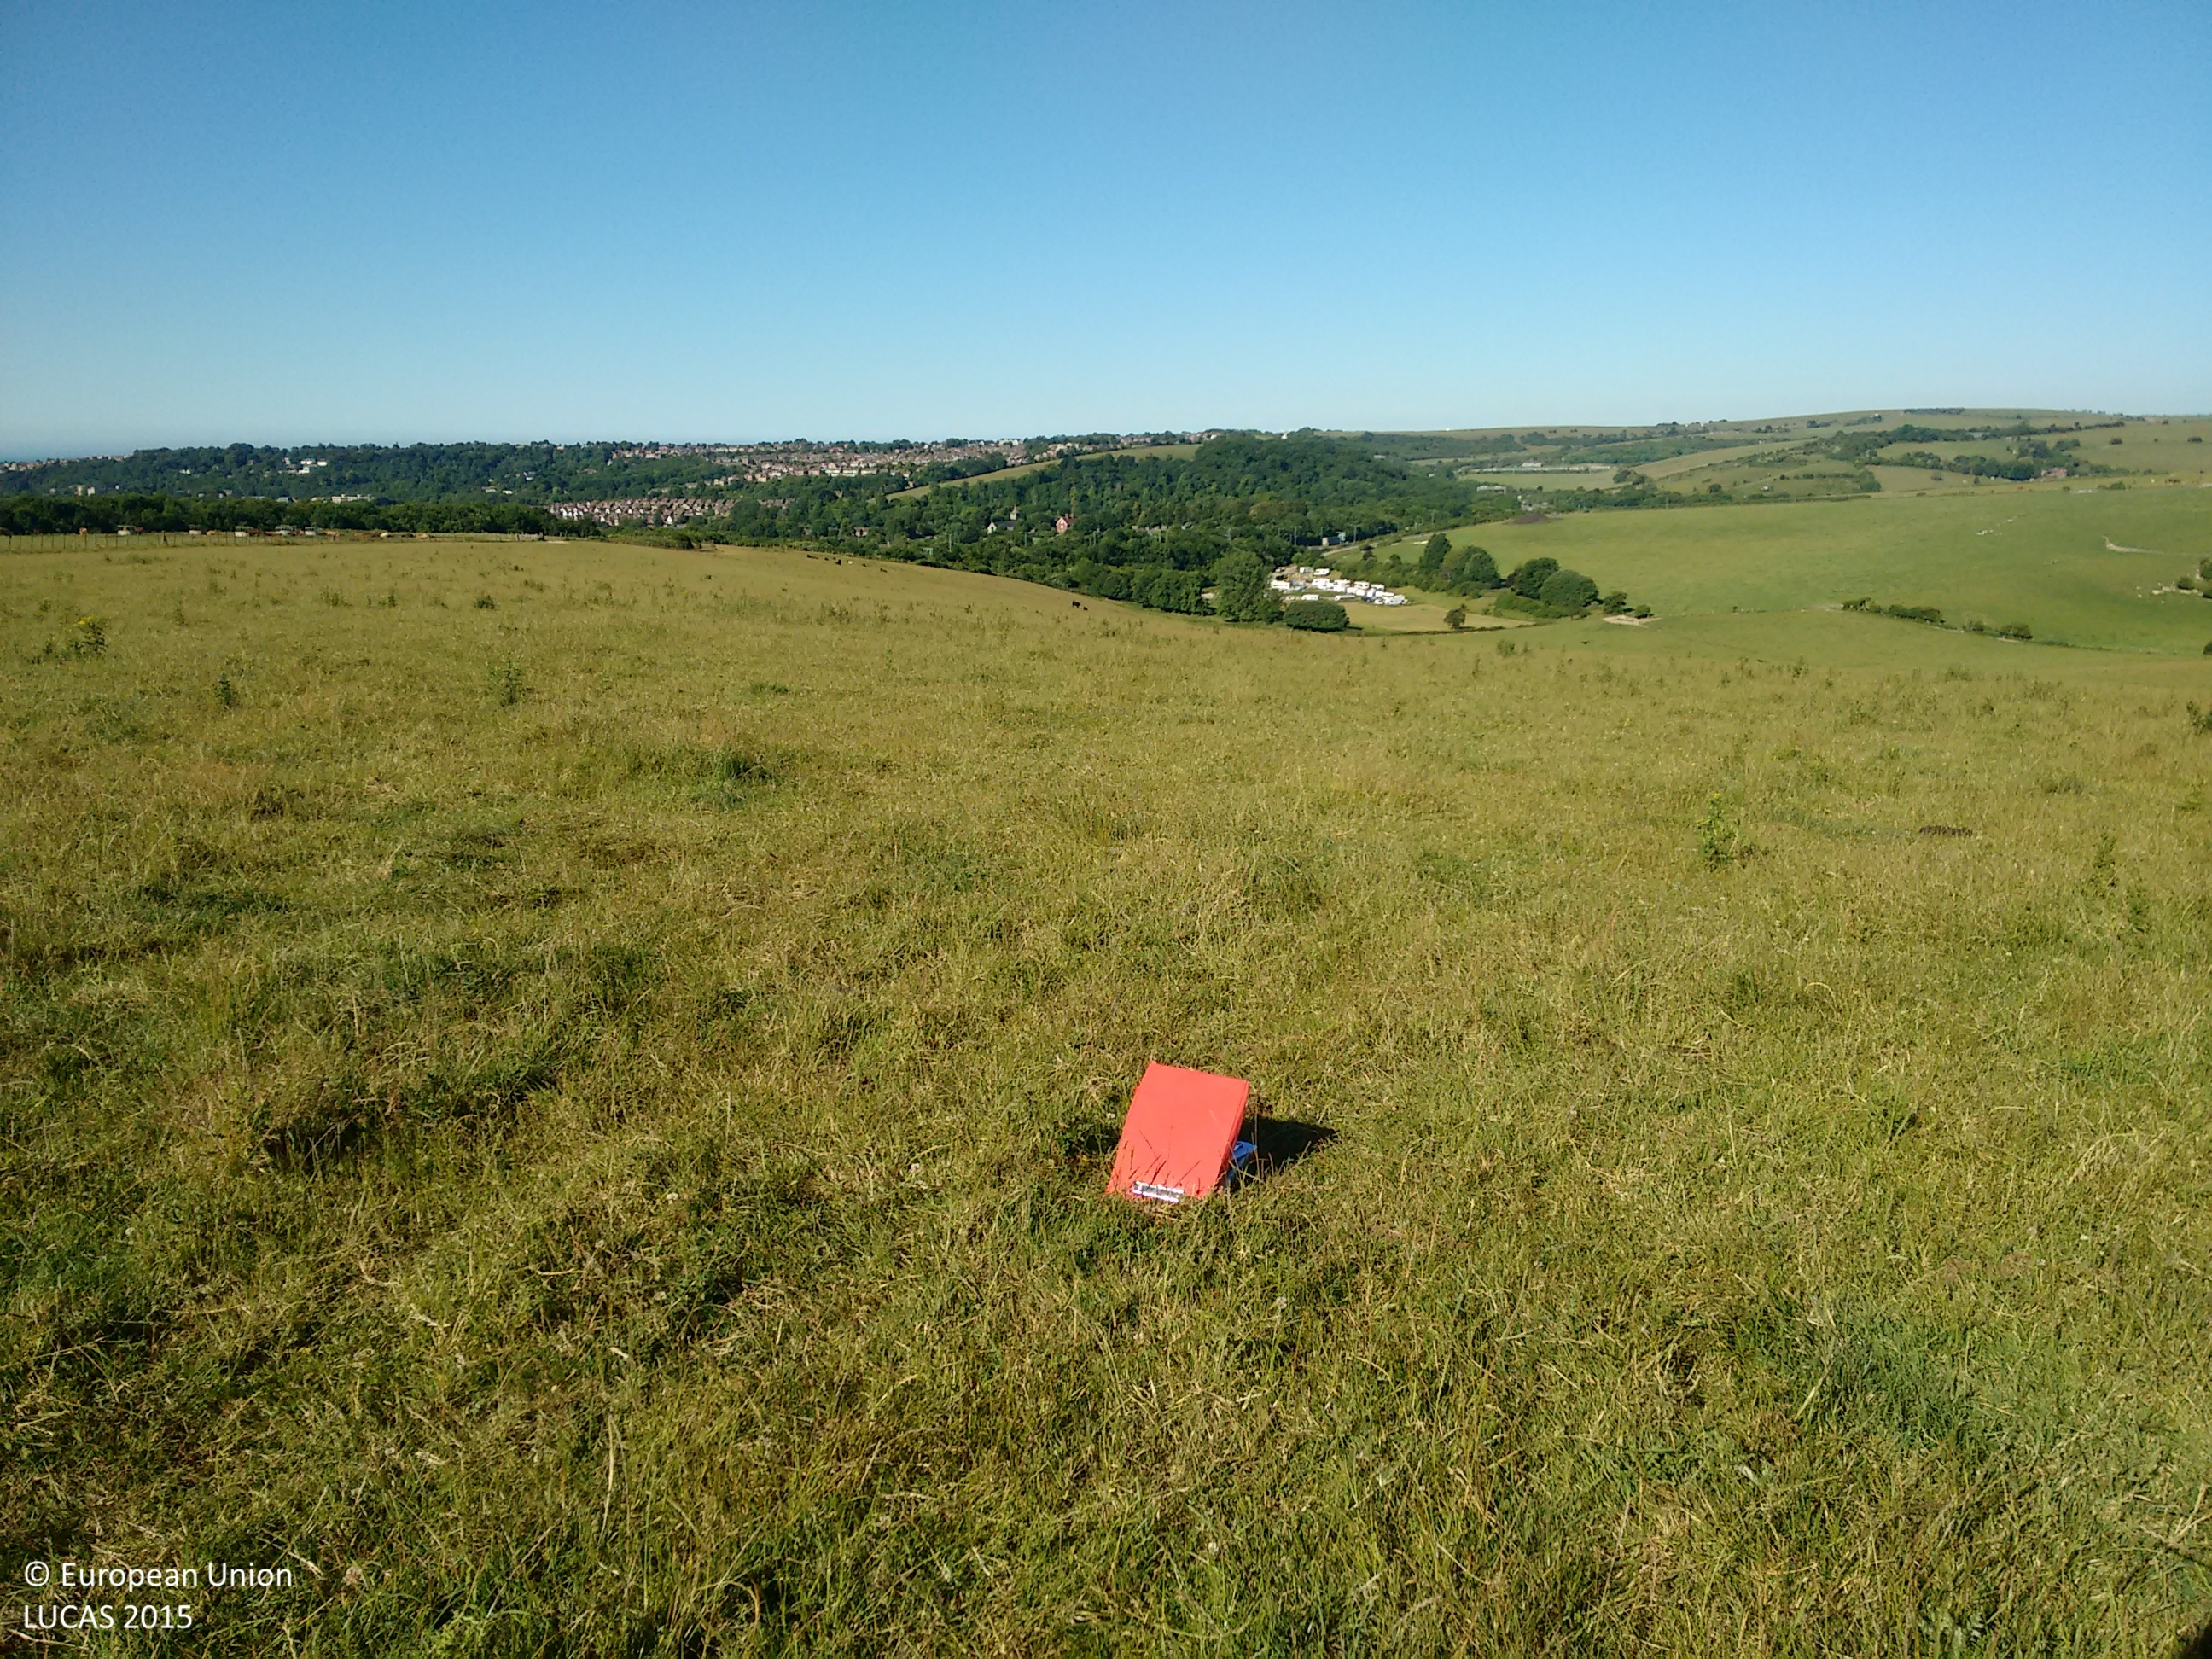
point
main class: Grassland
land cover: Grassland without tree/shrub cover
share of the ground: > 75 %
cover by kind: herbaceous plants 100 %
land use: Agriculture (excluding fallow land and kitchen gardens)
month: June
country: GB
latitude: 50.8730
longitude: -0.1381
